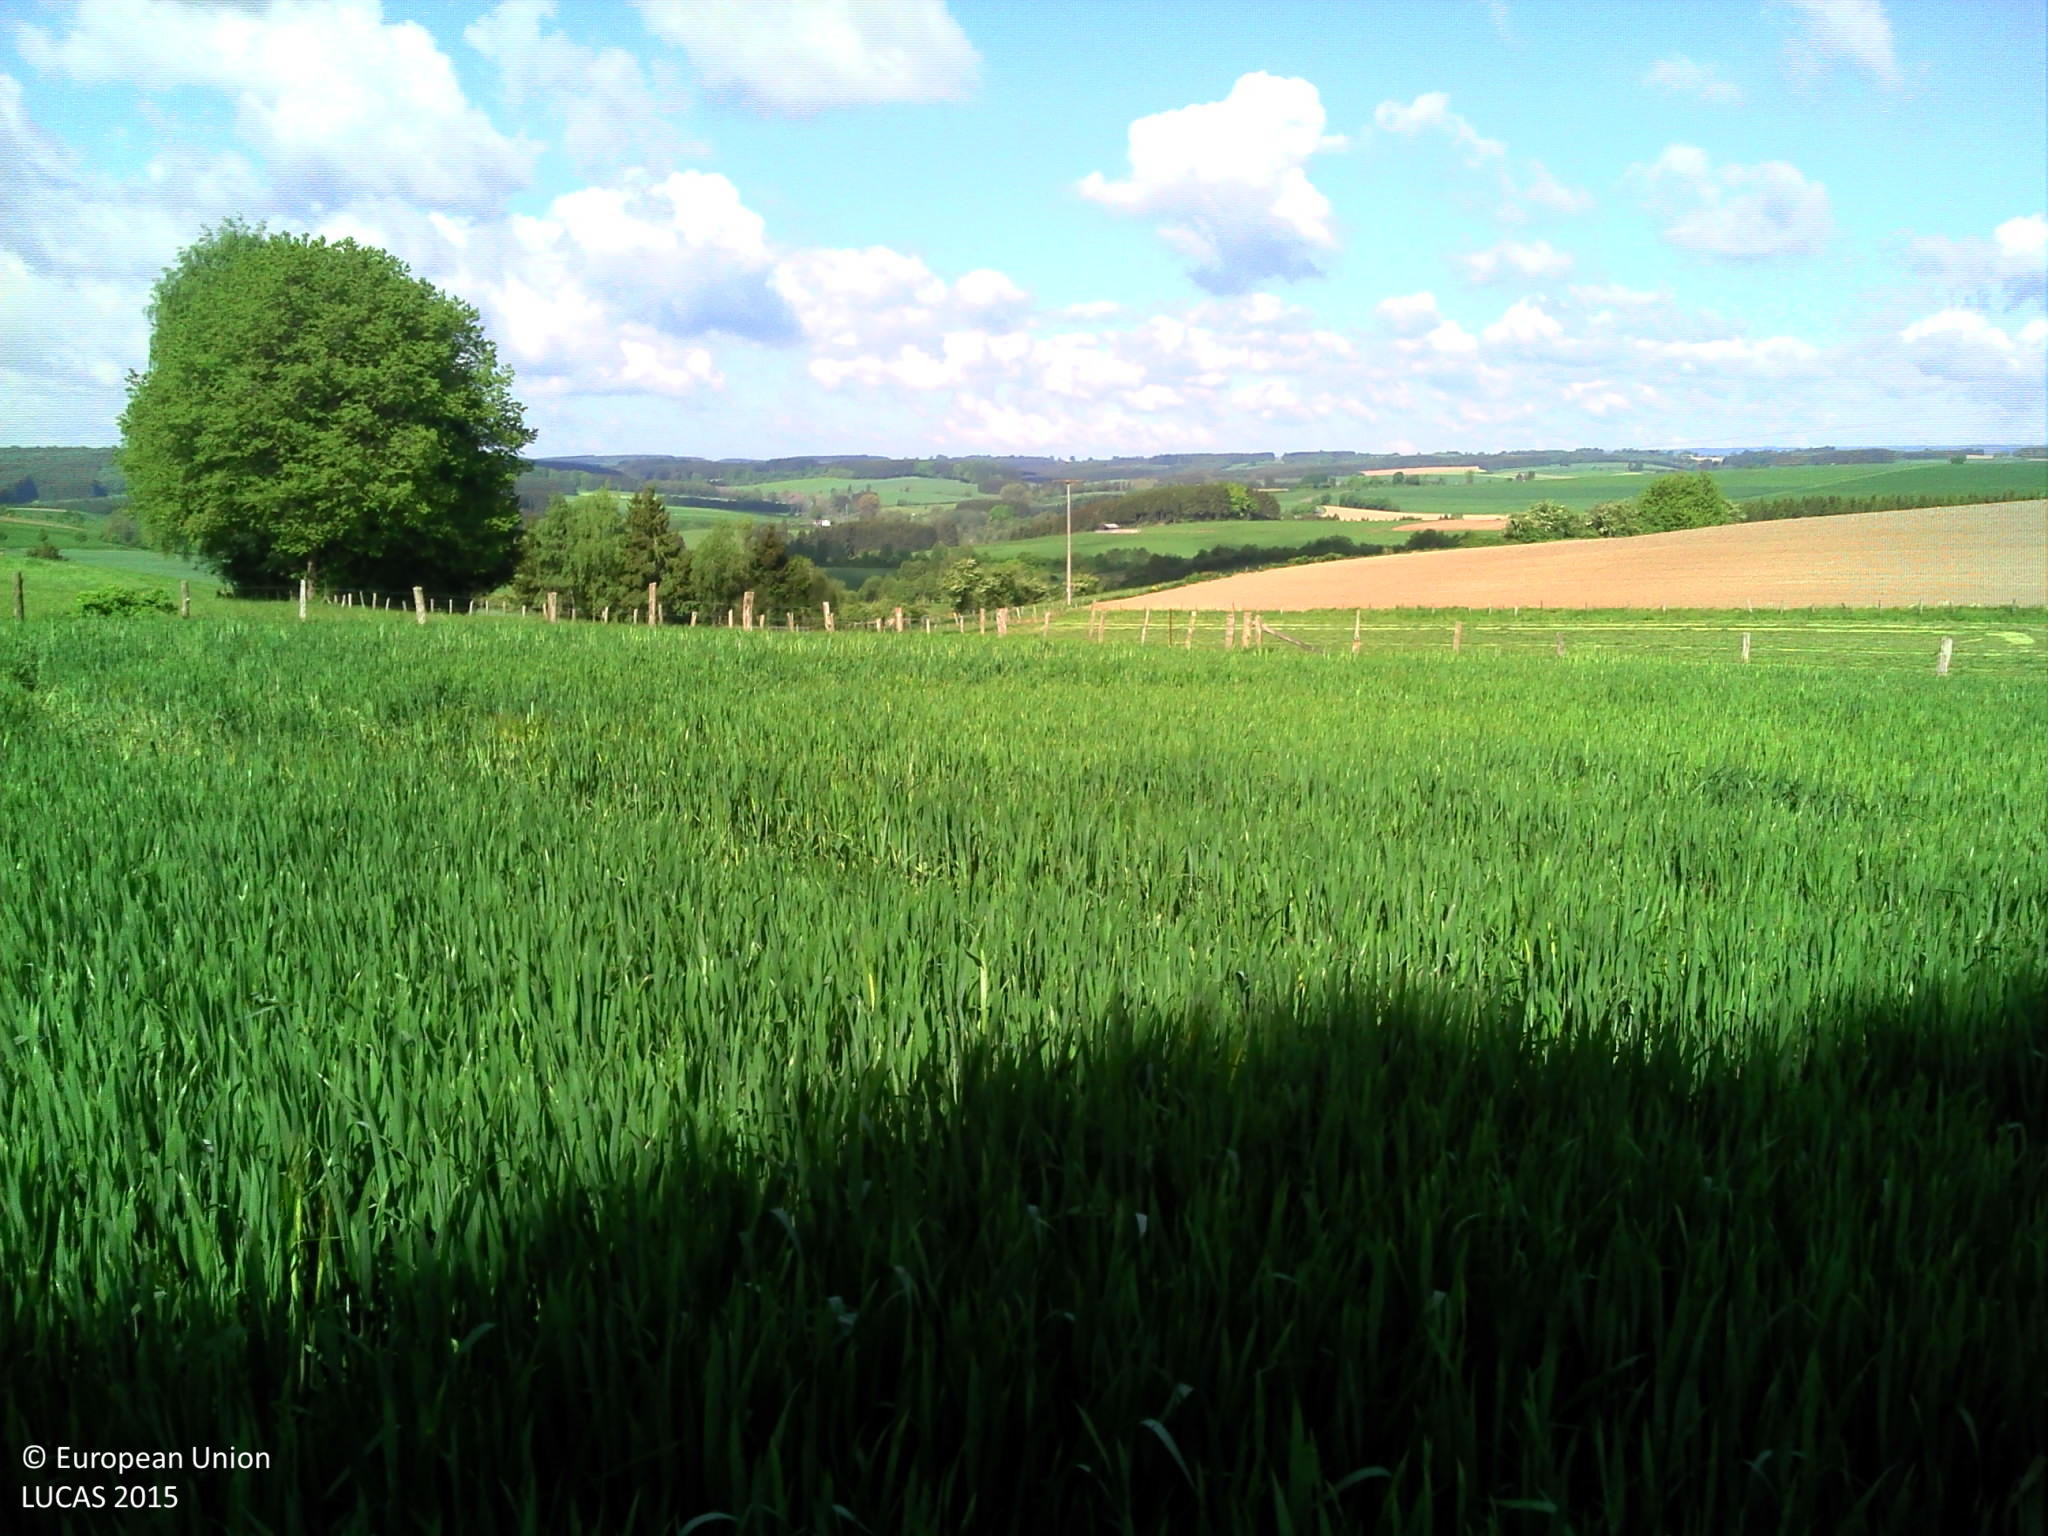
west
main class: Cropland
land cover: Common wheat
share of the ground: > 75 %
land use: Agriculture (excluding fallow land and kitchen gardens)
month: May
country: LU
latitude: 50.1325
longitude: 6.0120
